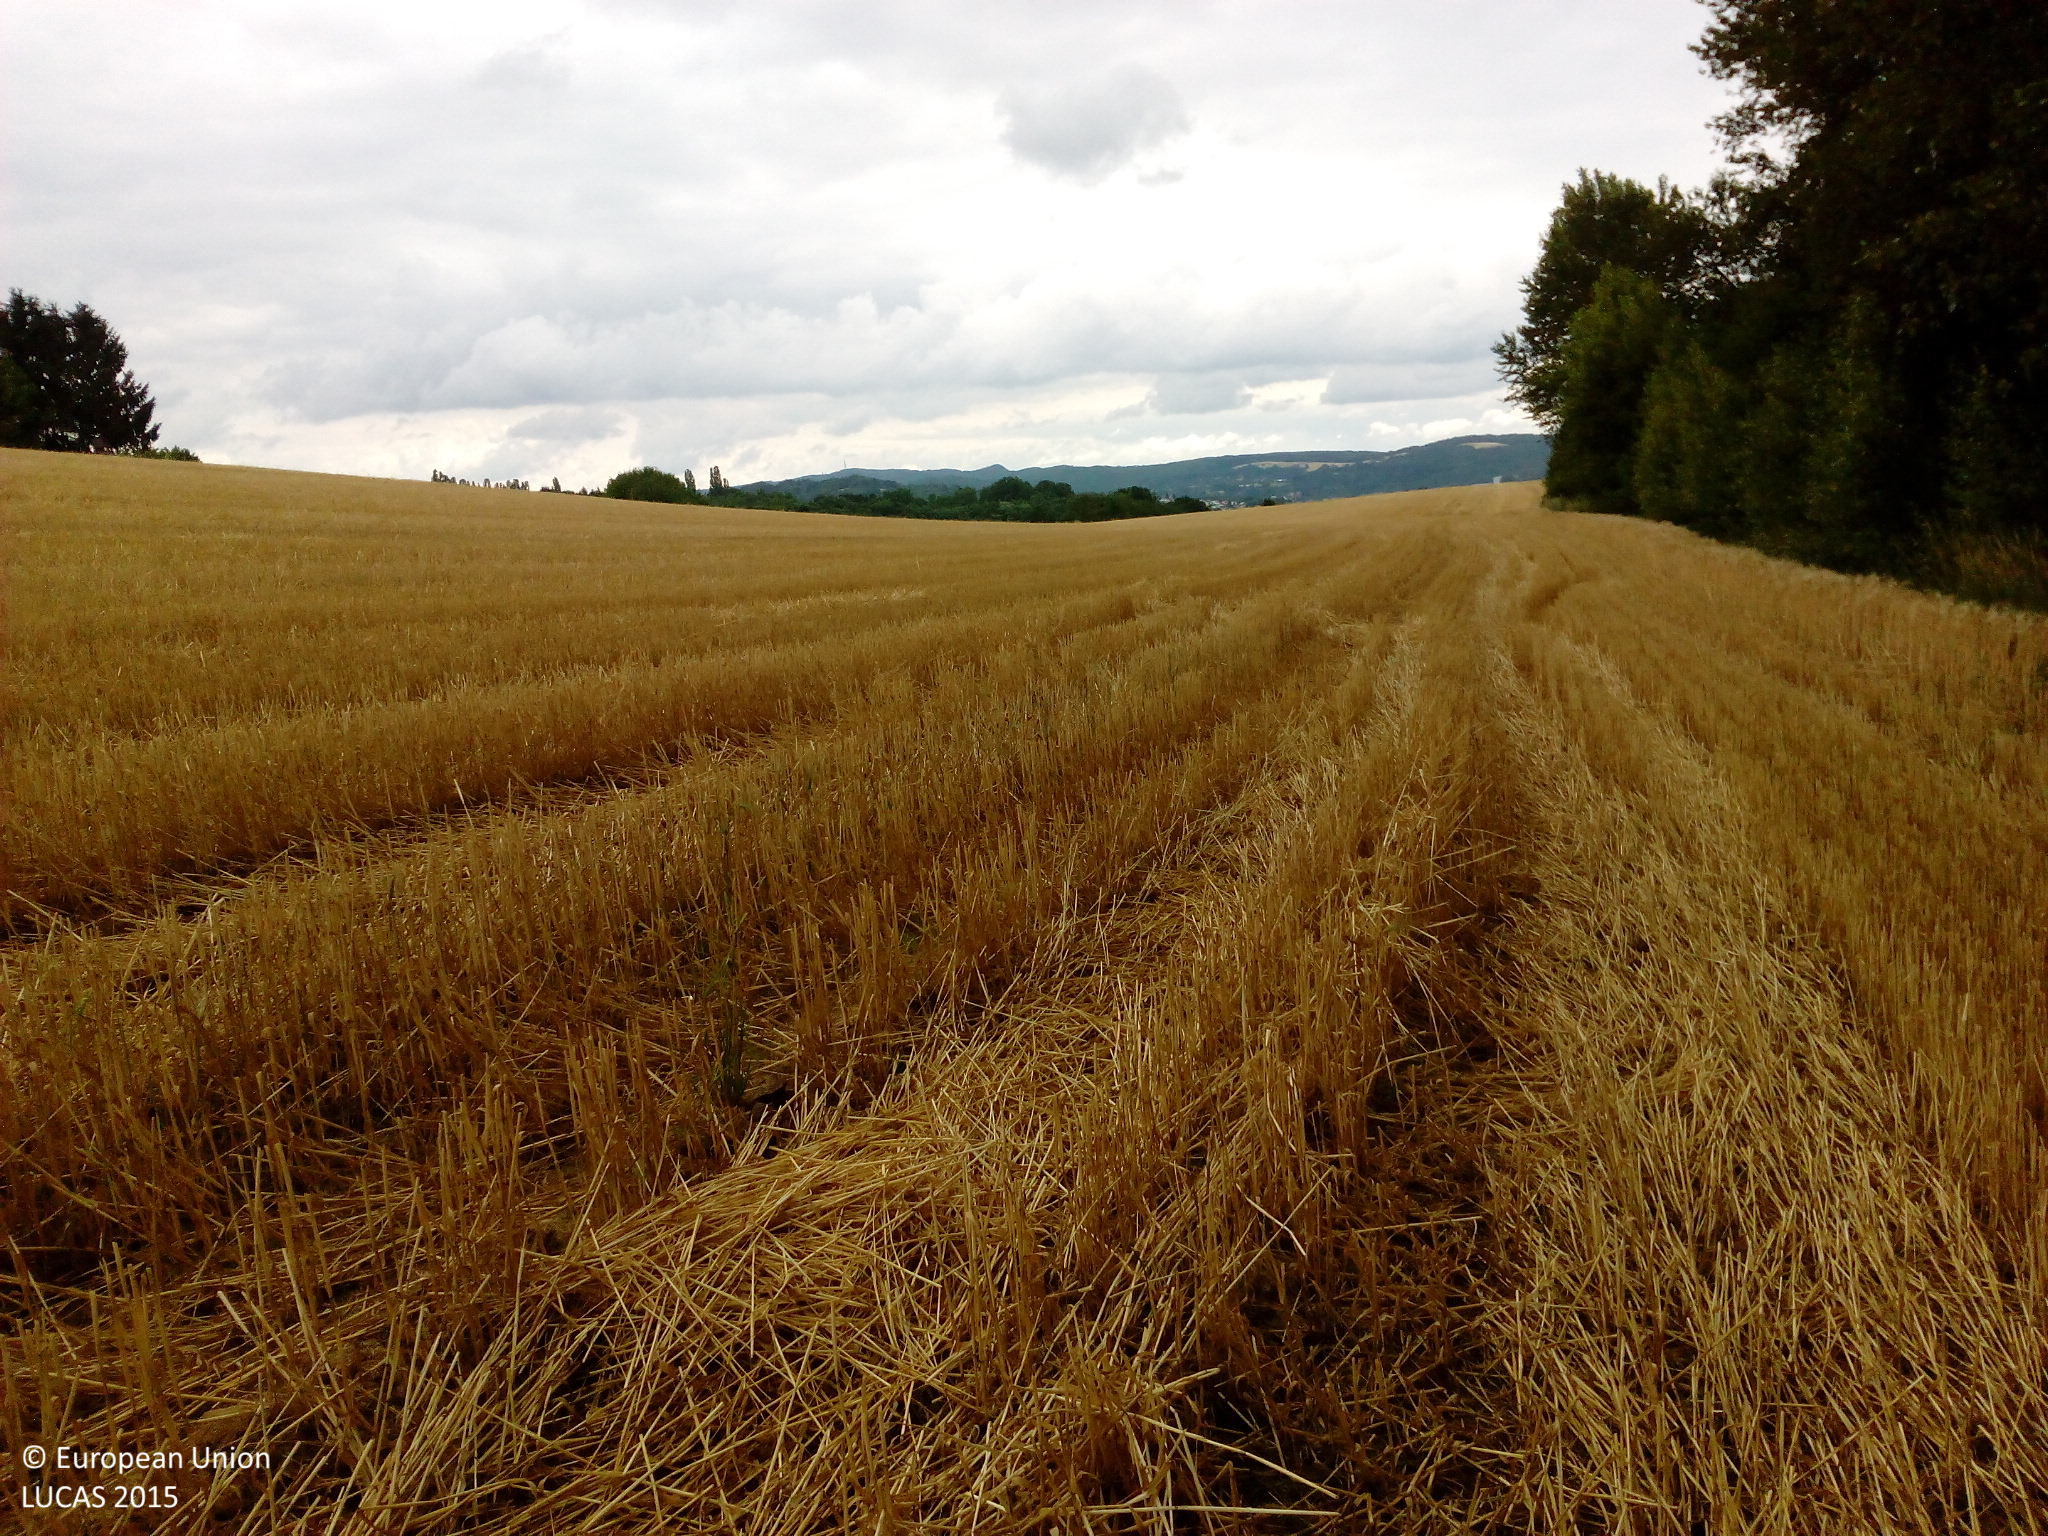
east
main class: Cropland
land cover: Barley
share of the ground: > 75 %
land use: Agriculture (excluding fallow land and kitchen gardens)
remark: Harvested field
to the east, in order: Barley
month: July
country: DE
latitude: 49.3748
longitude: 7.1494
